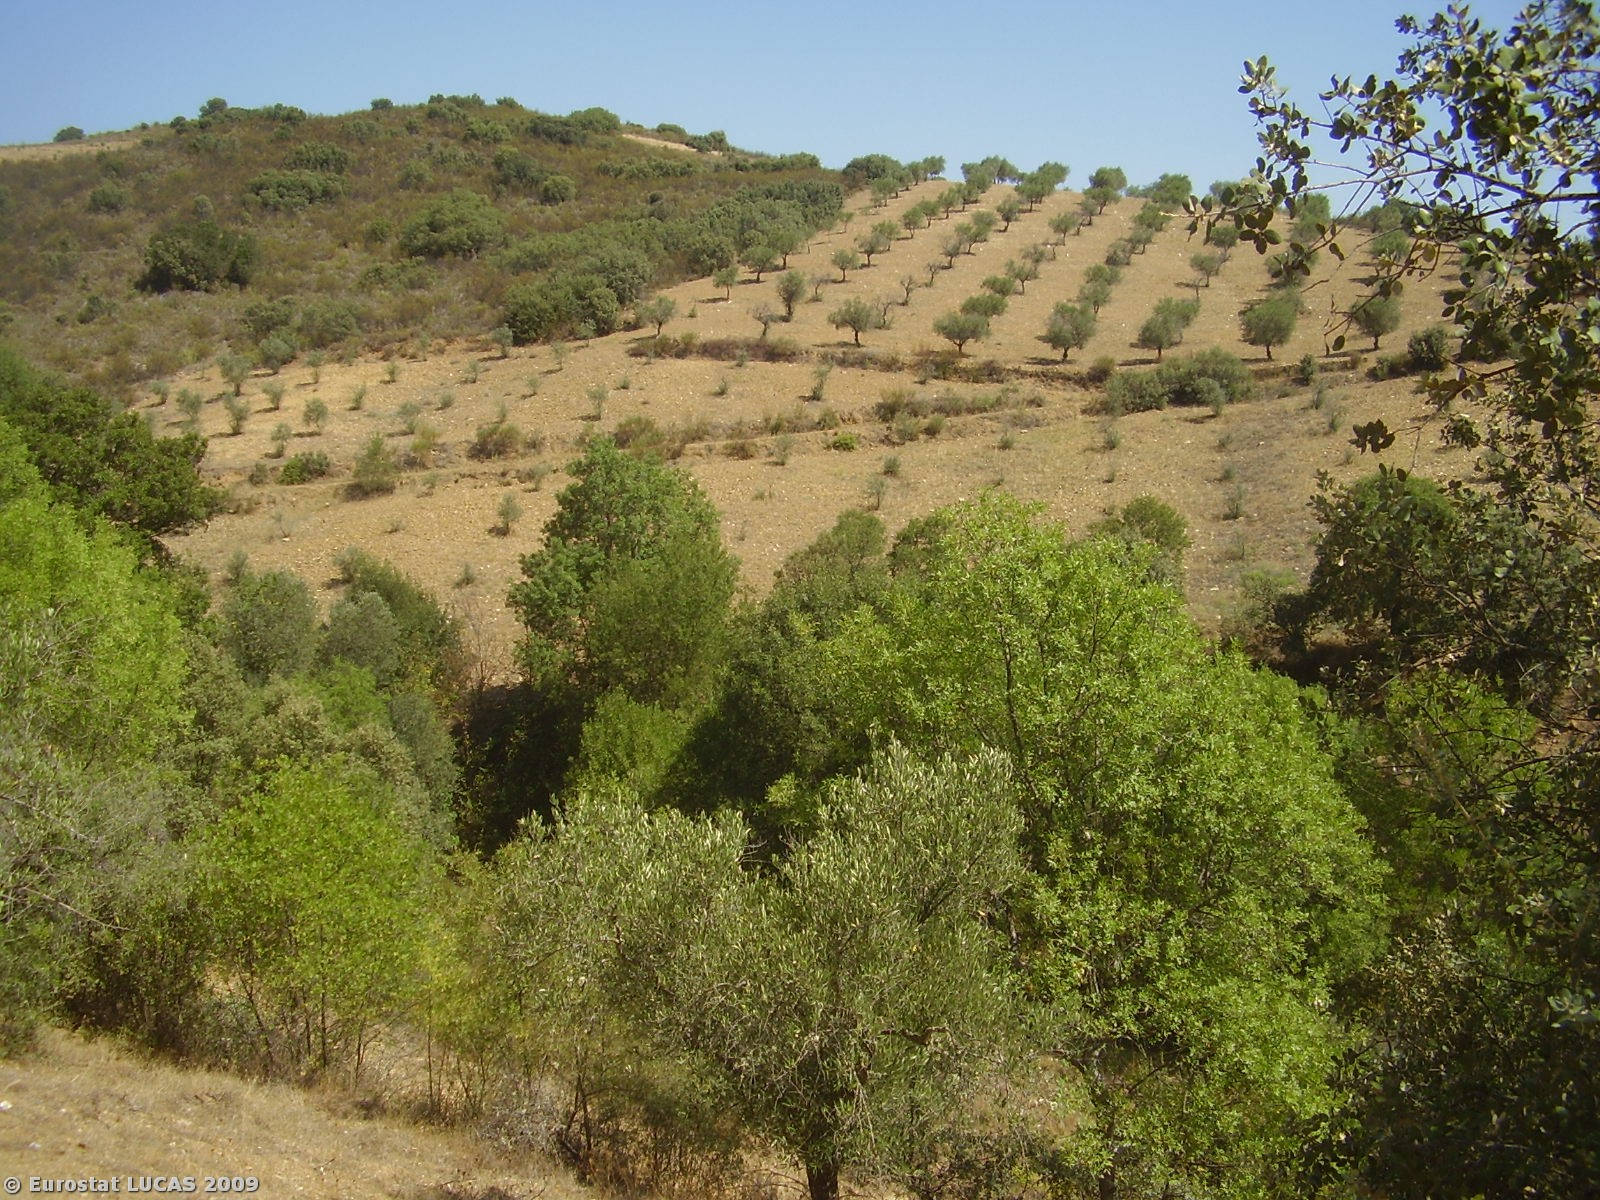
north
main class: Cropland
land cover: Olive groves
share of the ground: 10 - 25 %
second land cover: Spontaneously vegetated surfaces
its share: < 10 %
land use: Agriculture (excluding fallow land and kitchen gardens)
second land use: Fallow land
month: August
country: PT
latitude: 41.4366
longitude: -6.8285
